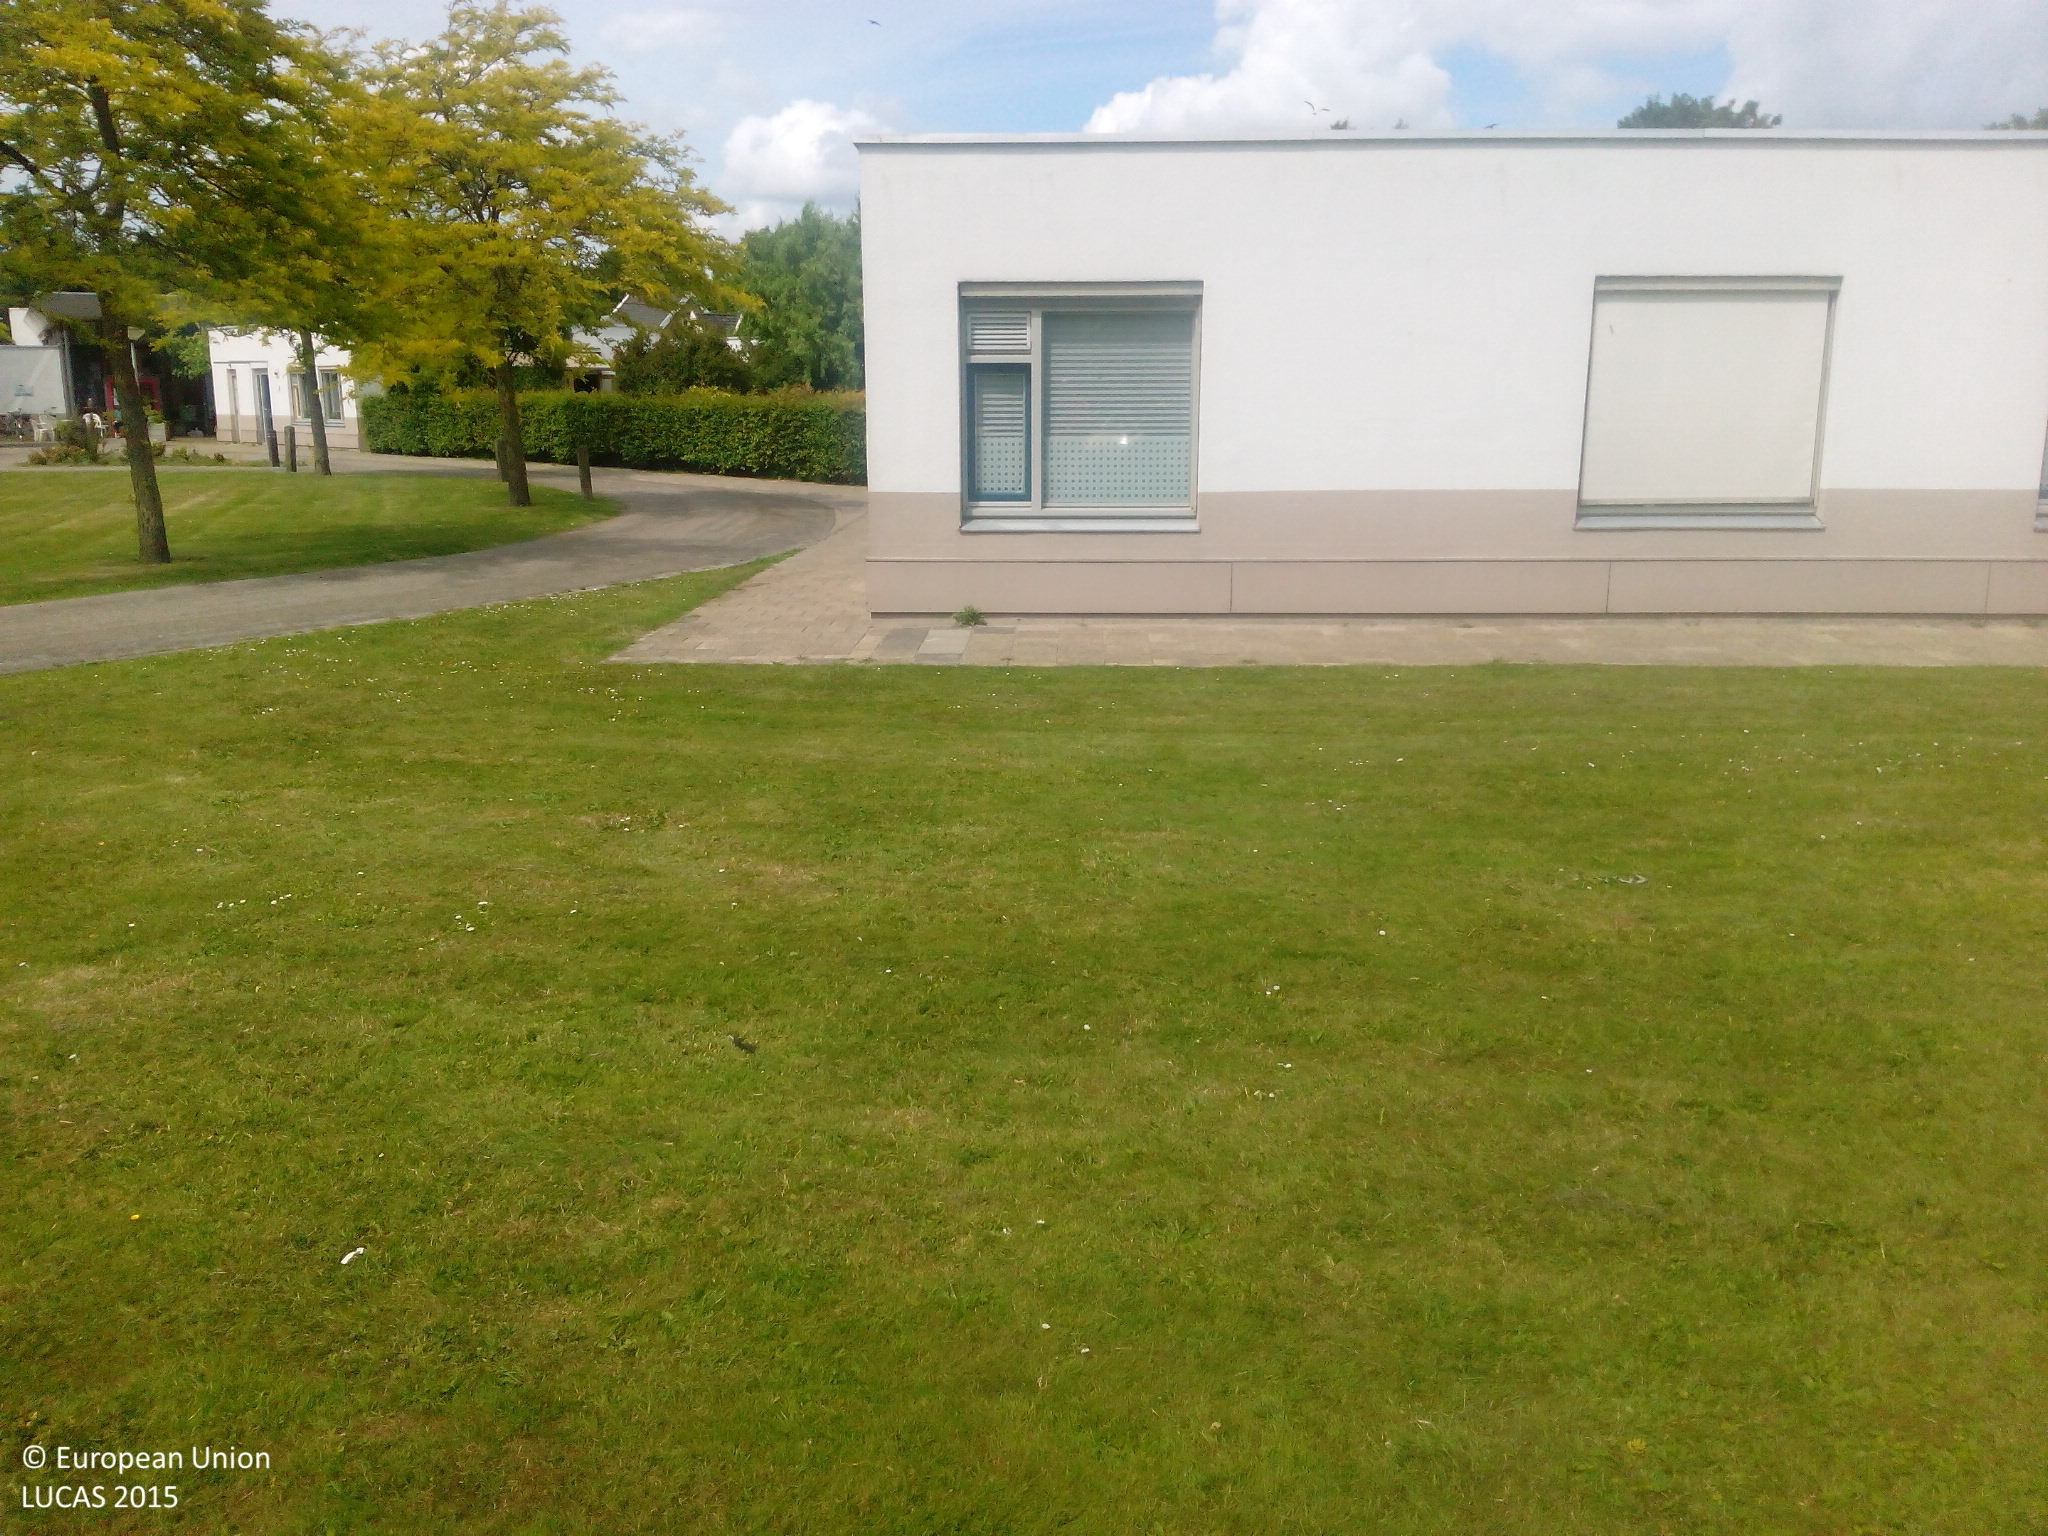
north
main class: Woodland
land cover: Broadleaved woodland
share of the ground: 25 - 50 %
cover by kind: herbaceous plants 55 %, broadleaved forest trees 30 %, consolidated bare surface 15 %
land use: Residential
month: June
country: NL
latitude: 51.8366
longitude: 4.1460
